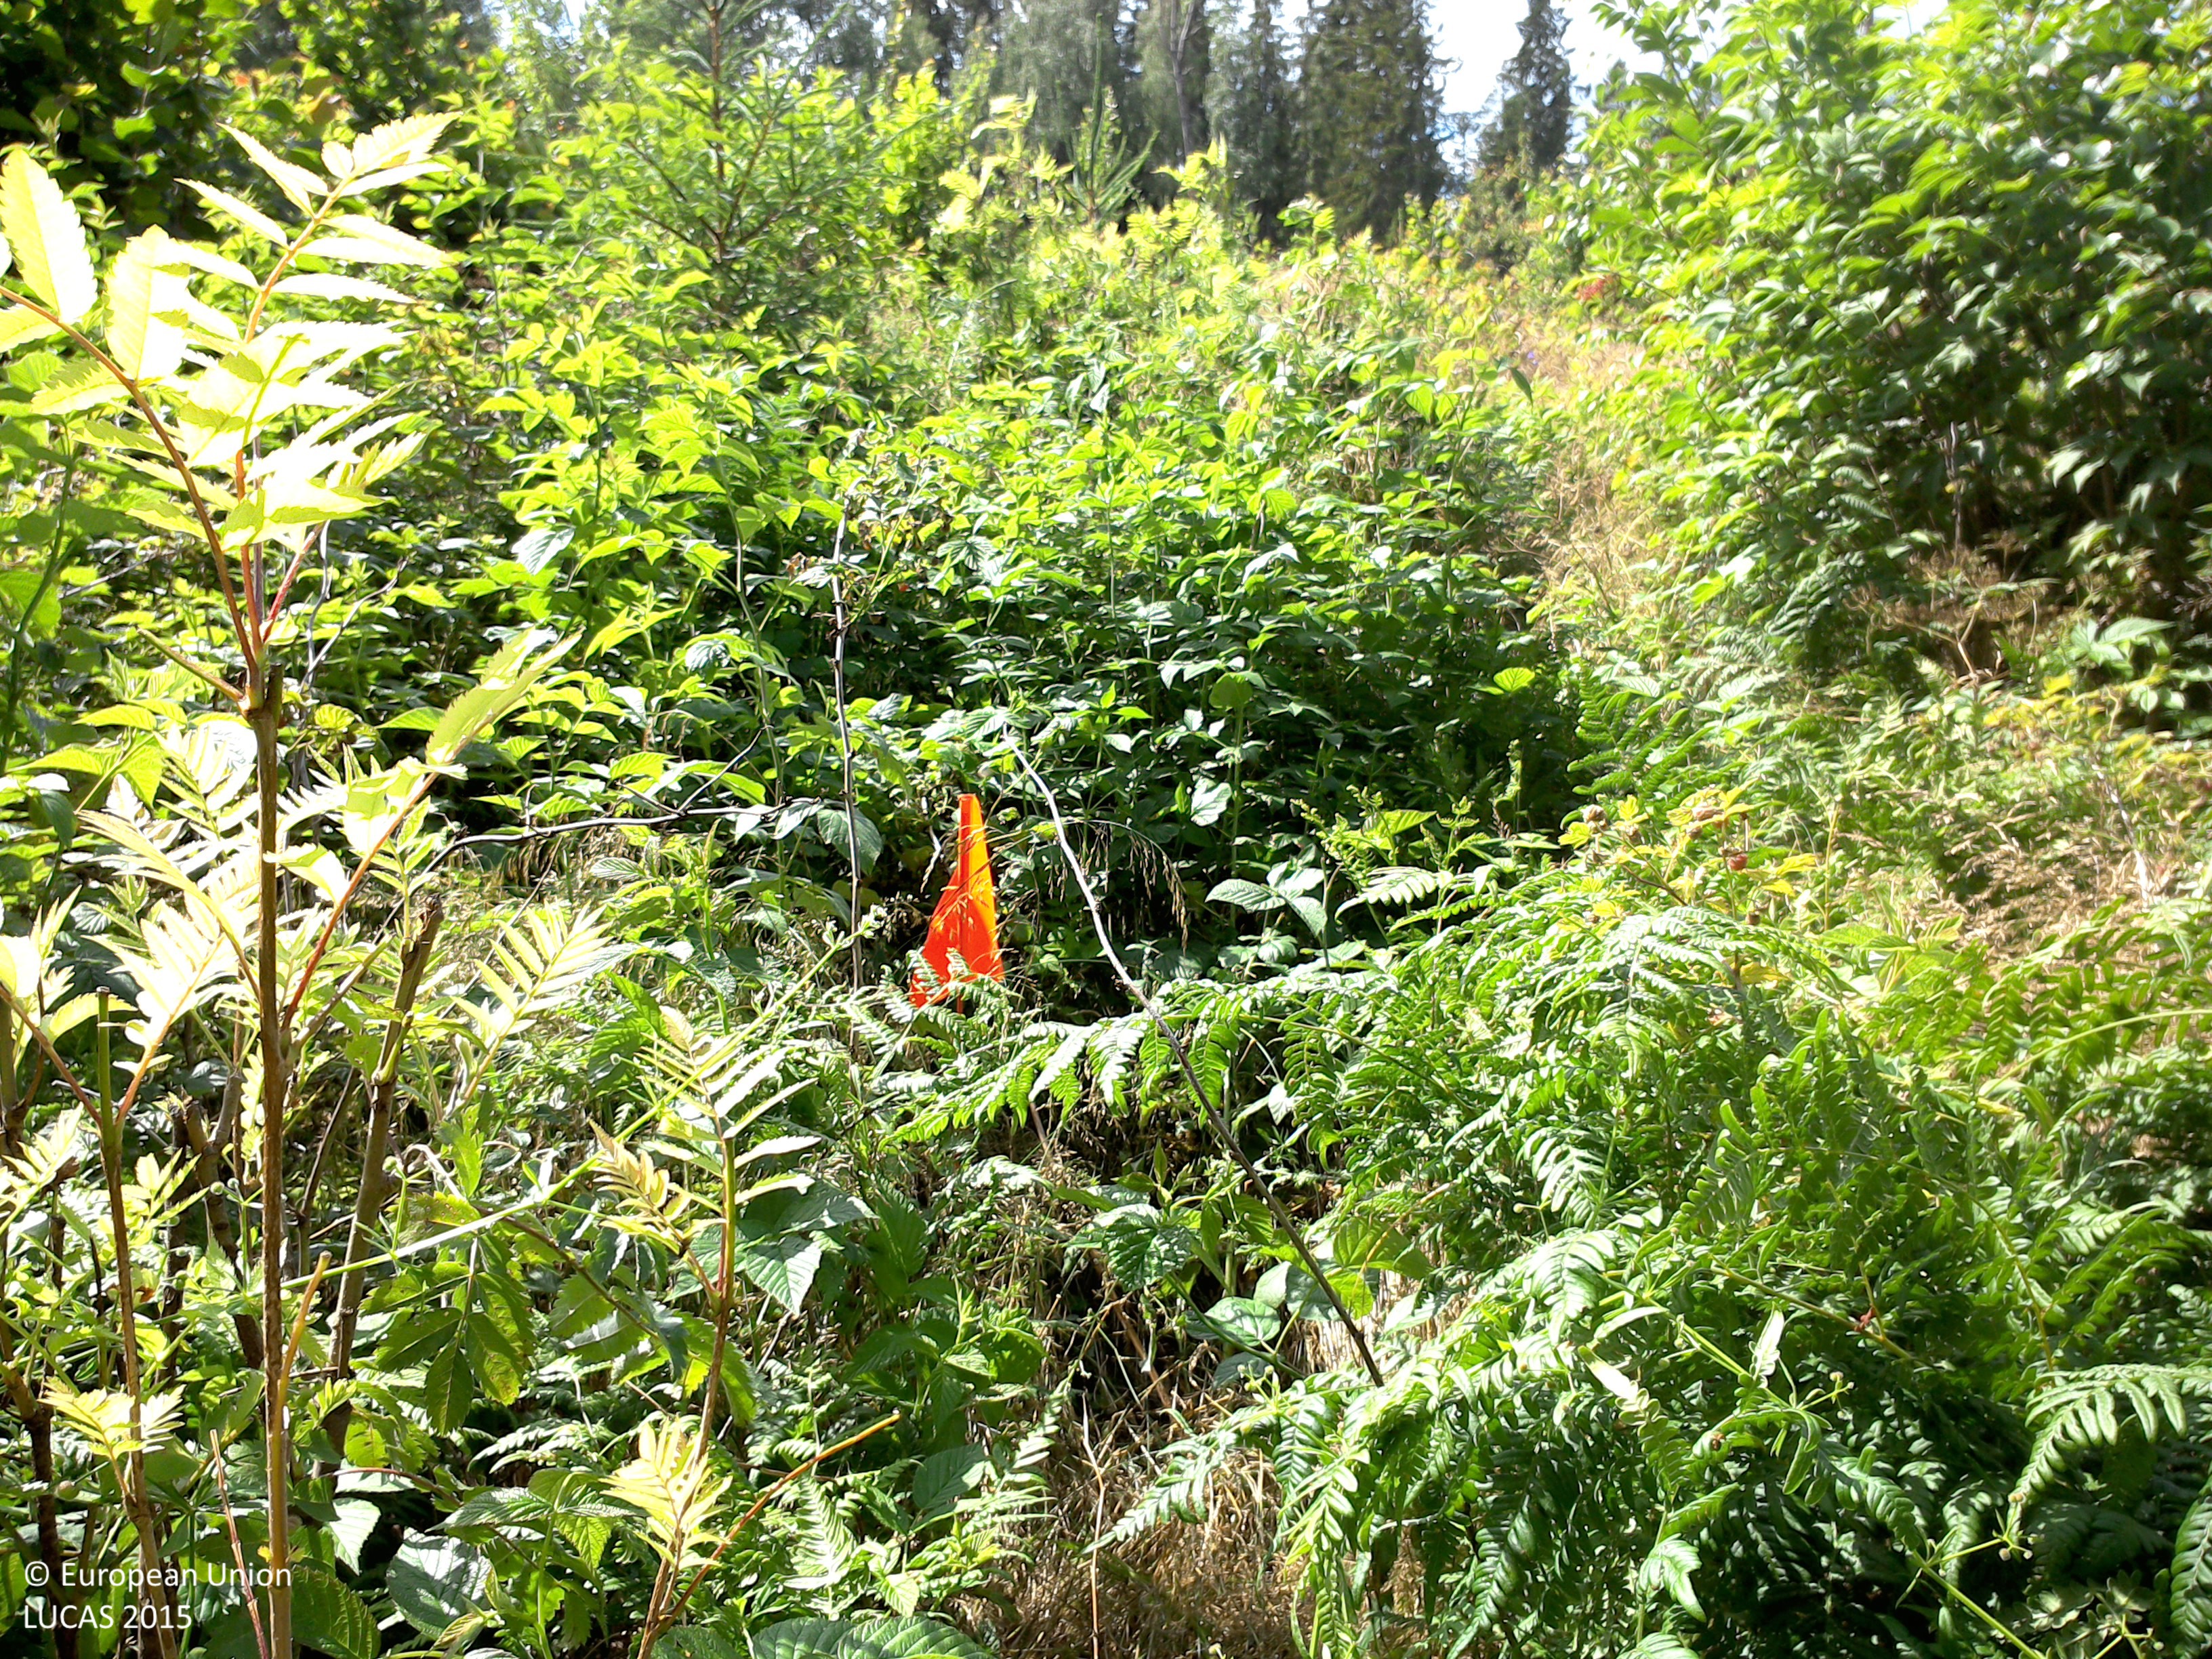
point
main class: Shrubland
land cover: Shrubland with sparse tree cover
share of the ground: > 75 %
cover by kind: shrubs 70 %, herbaceous plants 25 %, broadleaved forest trees 5 %
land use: Forestry
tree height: < 5 m
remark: Clear cut
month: July
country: SE
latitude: 57.7937
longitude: 16.0701
